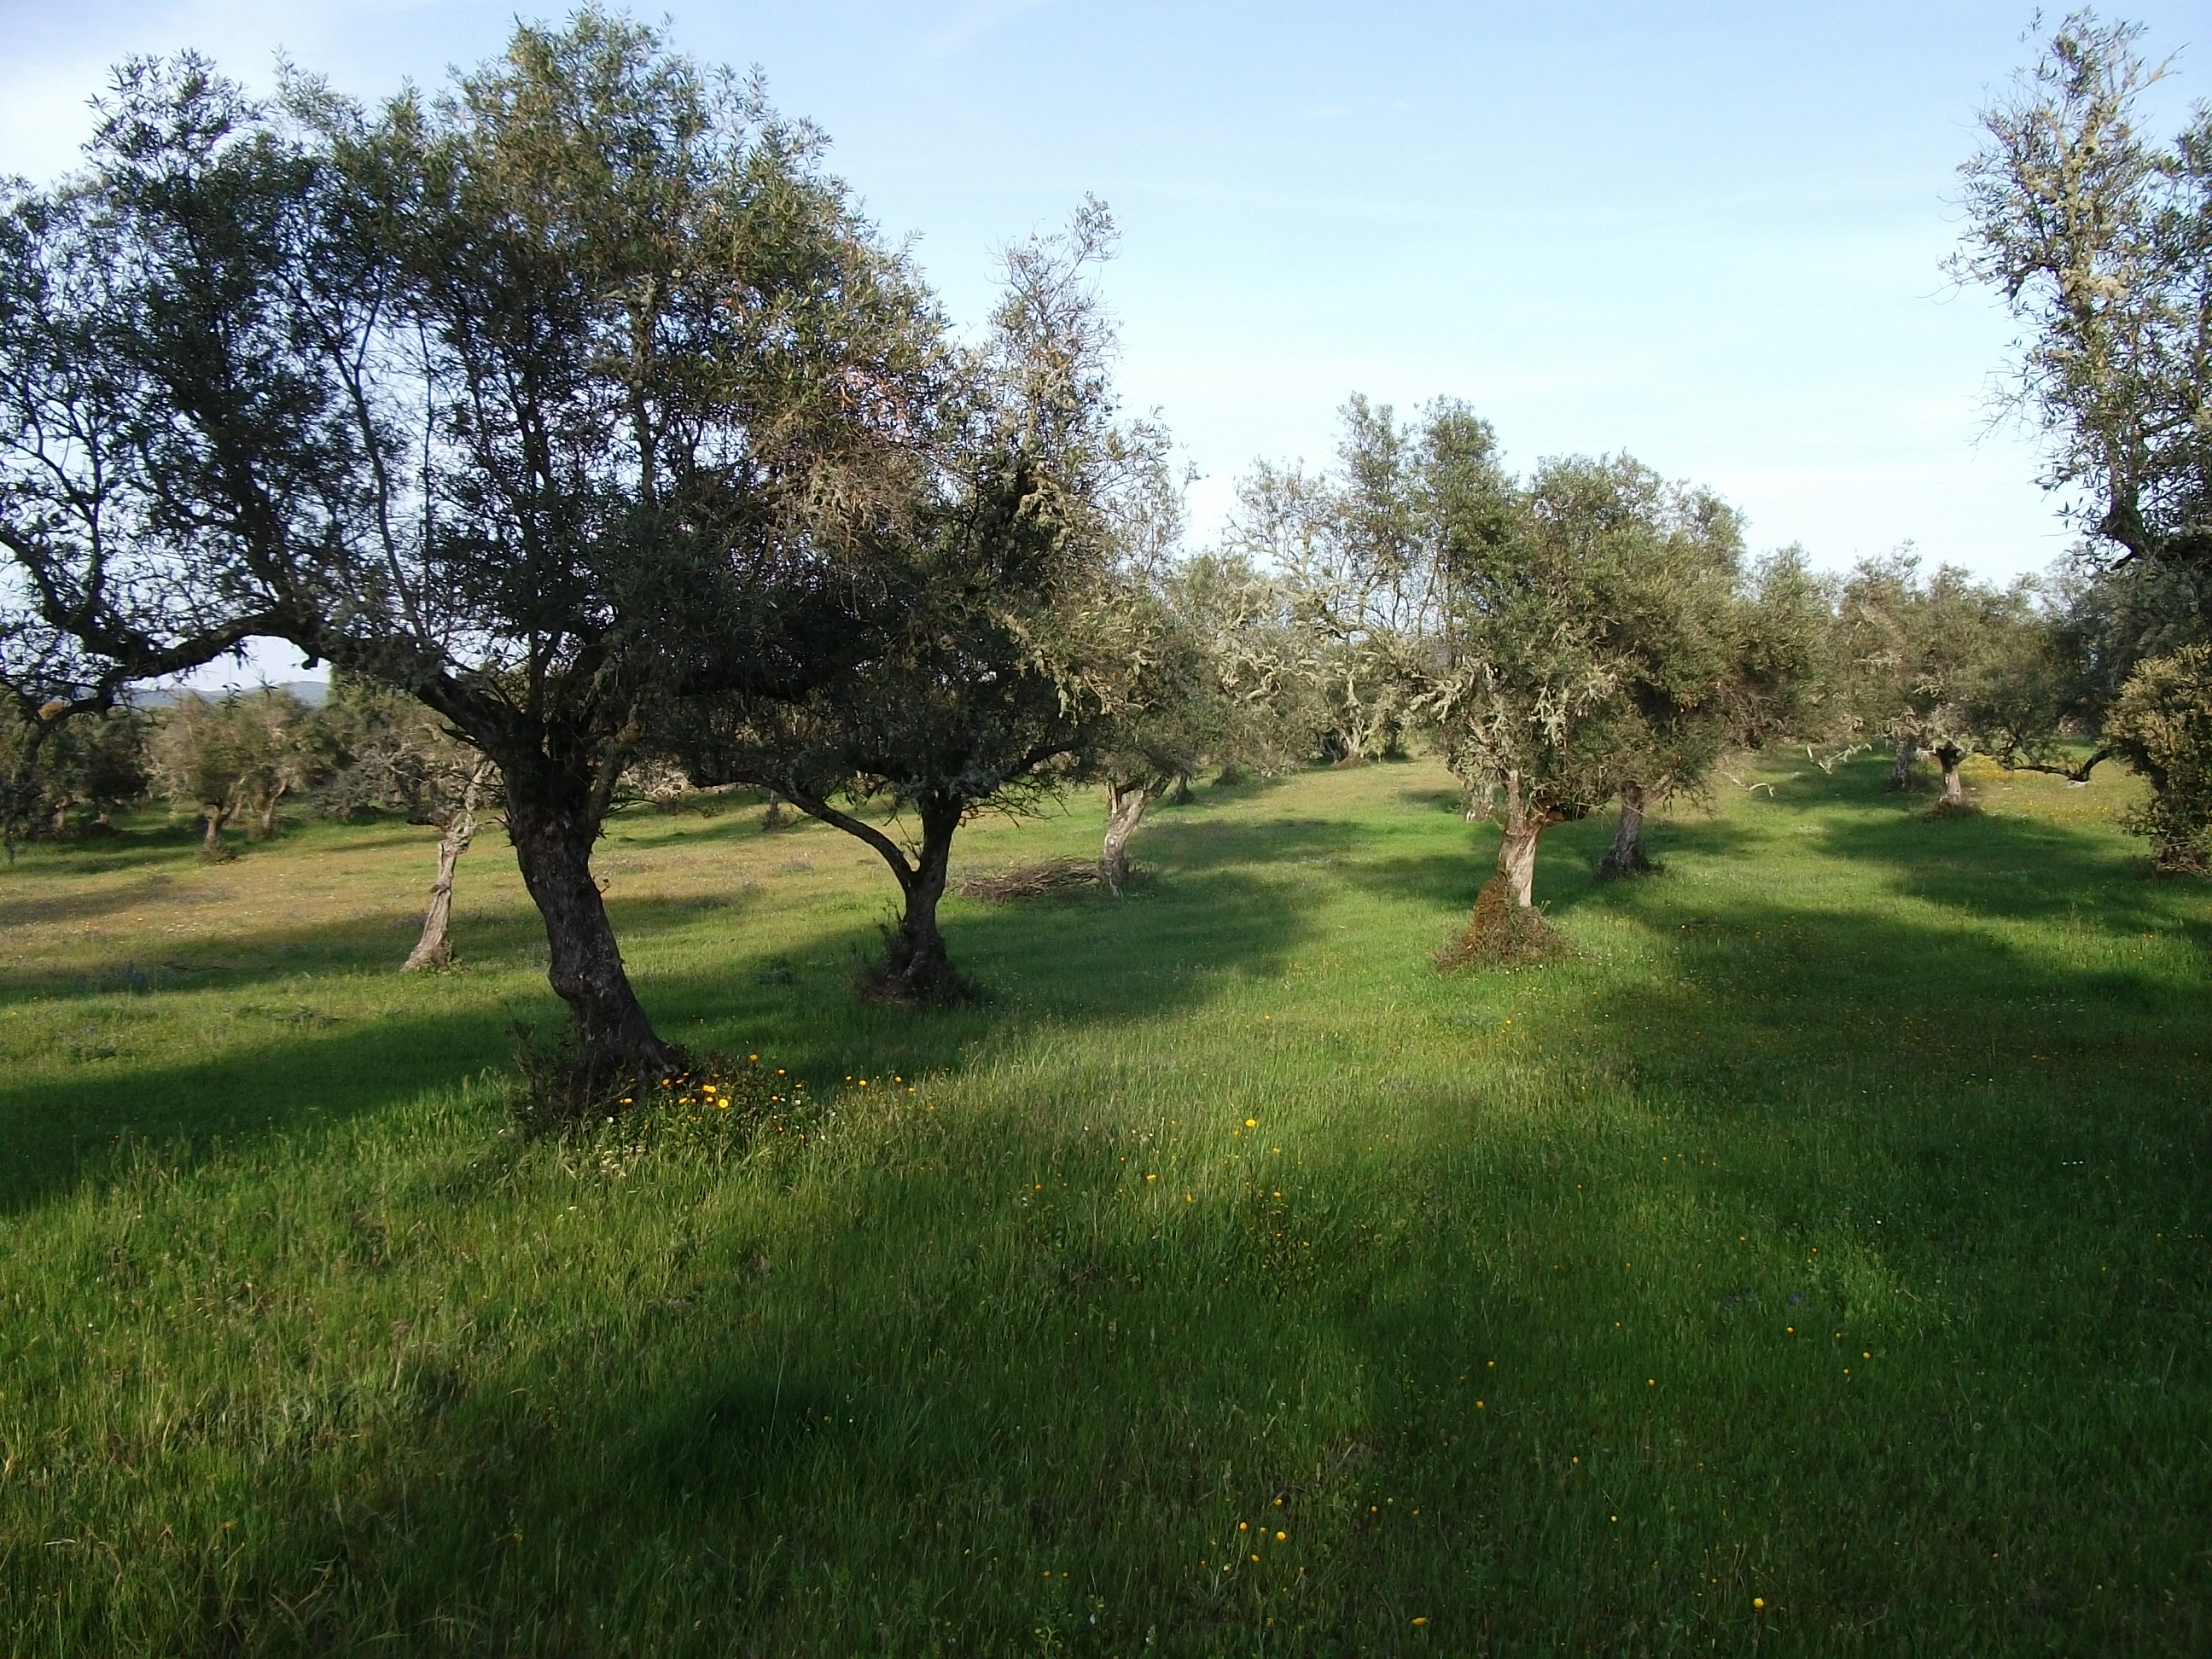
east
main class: Cropland
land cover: Olive groves
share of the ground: 25 - 50 %
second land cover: Spontaneously vegetated surfaces
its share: > 75 %
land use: Agriculture (excluding fallow land and kitchen gardens)
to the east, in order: Olive groves; Spontaneously vegetated surfaces; Electric lines; Olive groves; Dry stone walls; Olive groves; Dry stone walls; Fences; Single bushes/trees; Grassland without tree/shrub cover; Fences; Grass margins; Tracks; Grass margins; Fences; Broadleaved woodland
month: April
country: ES
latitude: 38.0798
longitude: -6.6358
